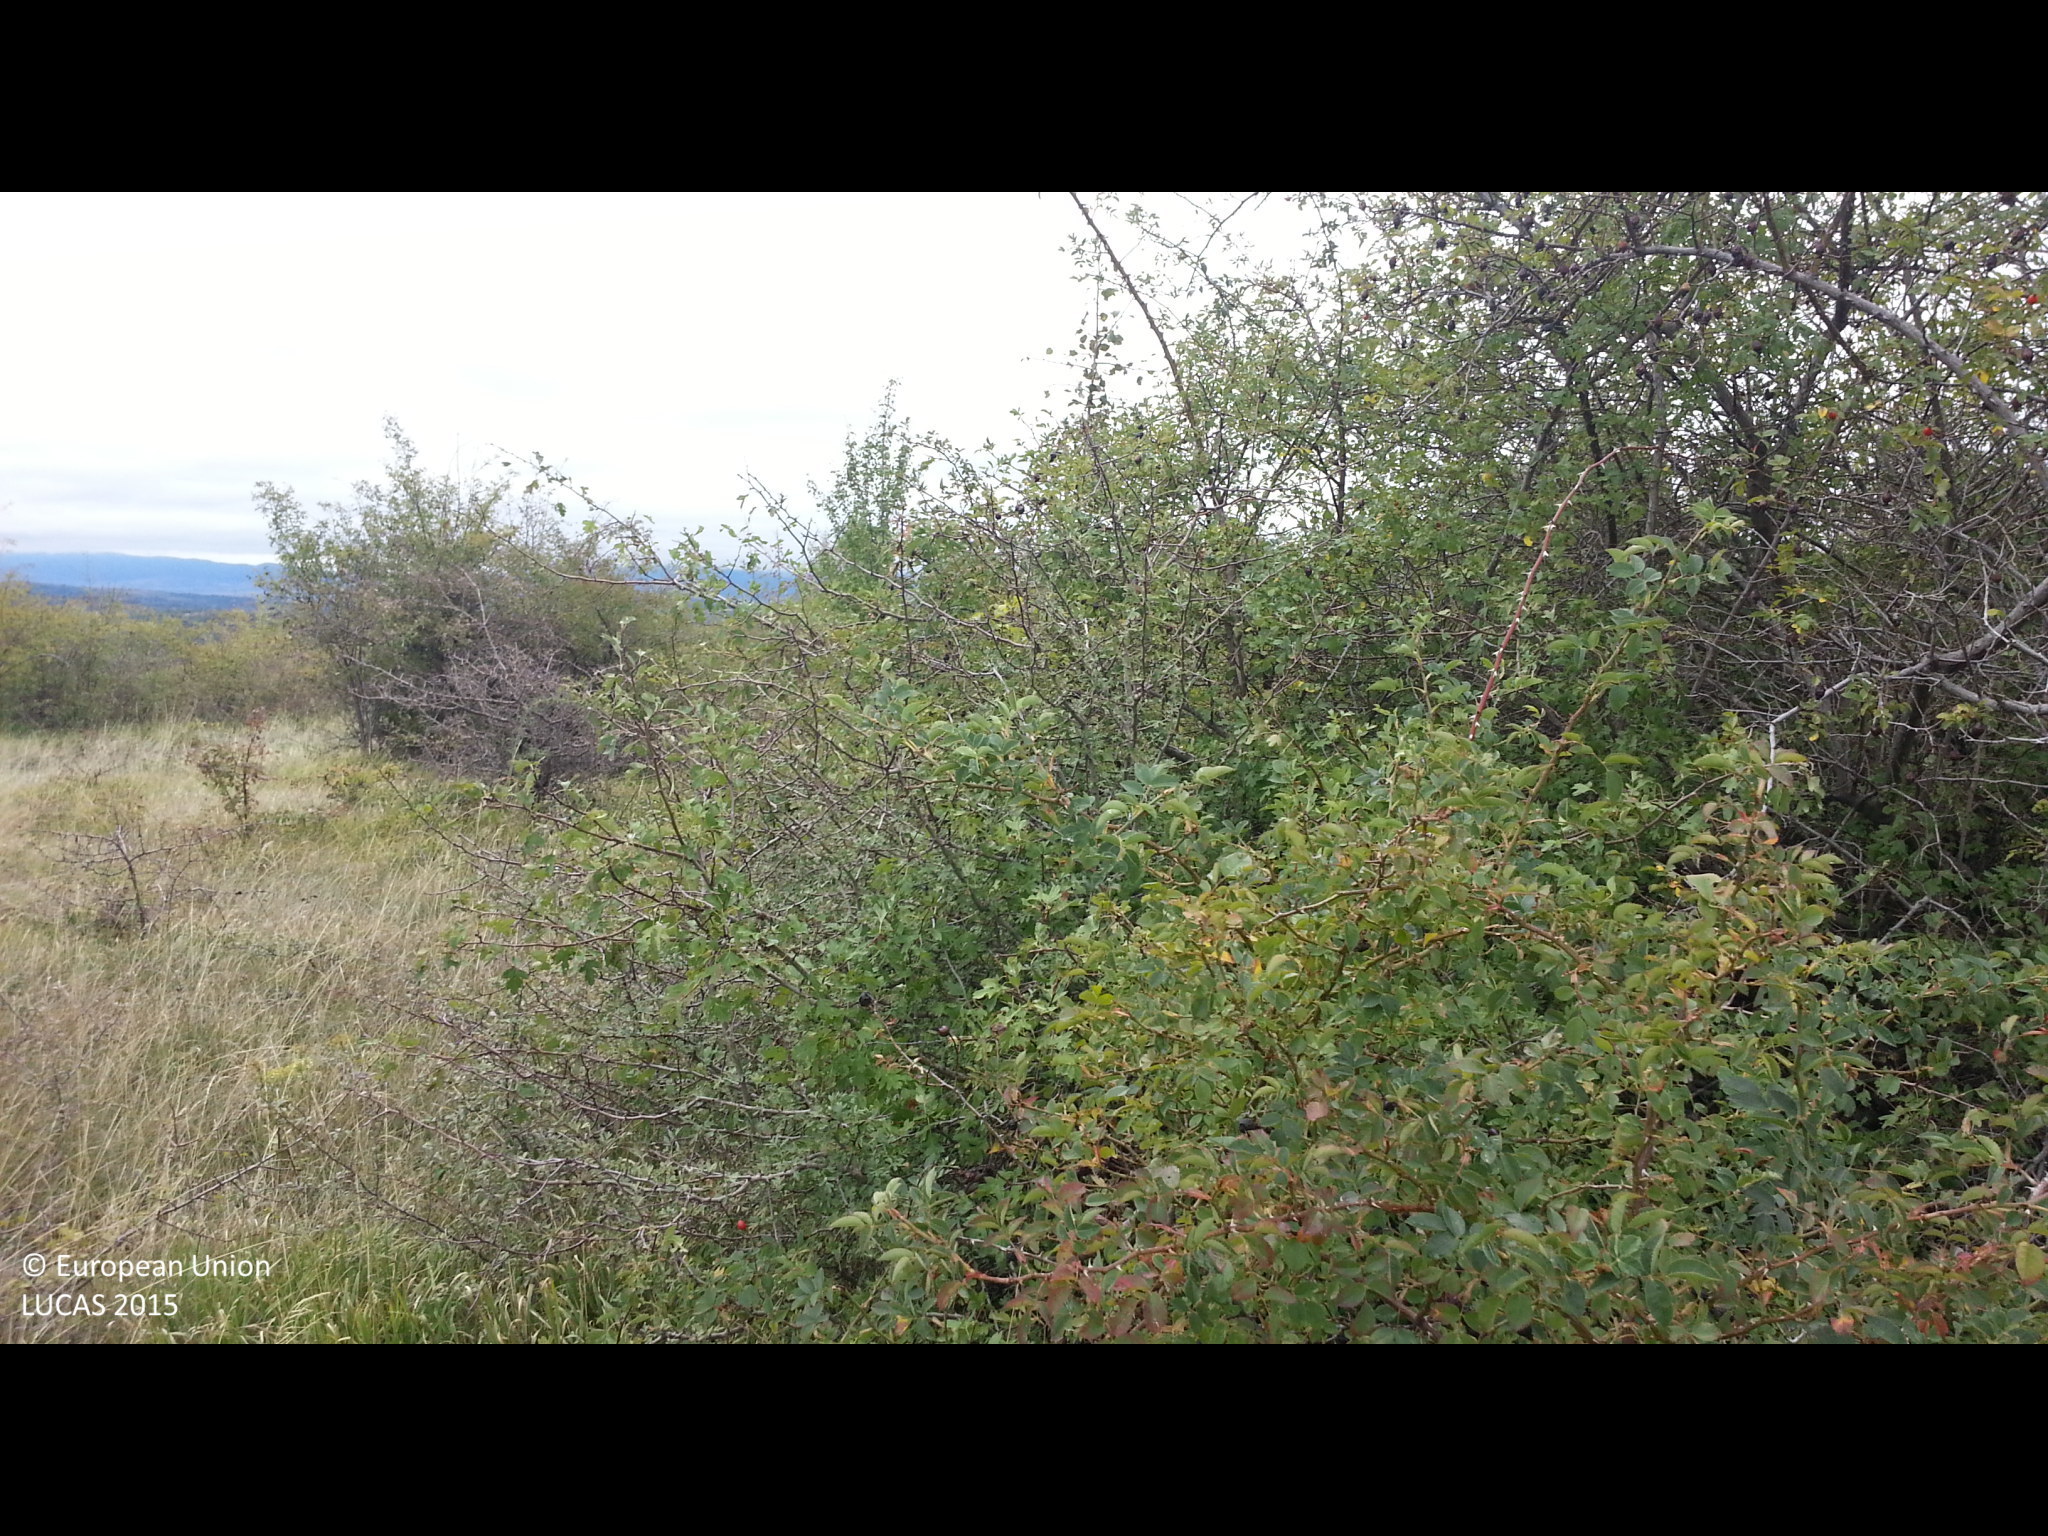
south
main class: Grassland
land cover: Grassland with sparse tree/shrub cover
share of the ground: > 75 %
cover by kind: herbaceous plants 90 %, broadleaved forest trees 5 %, shrubs 5 %
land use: Abandoned areas
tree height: < 5 m
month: September
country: BG
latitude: 42.5975
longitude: 22.8603
